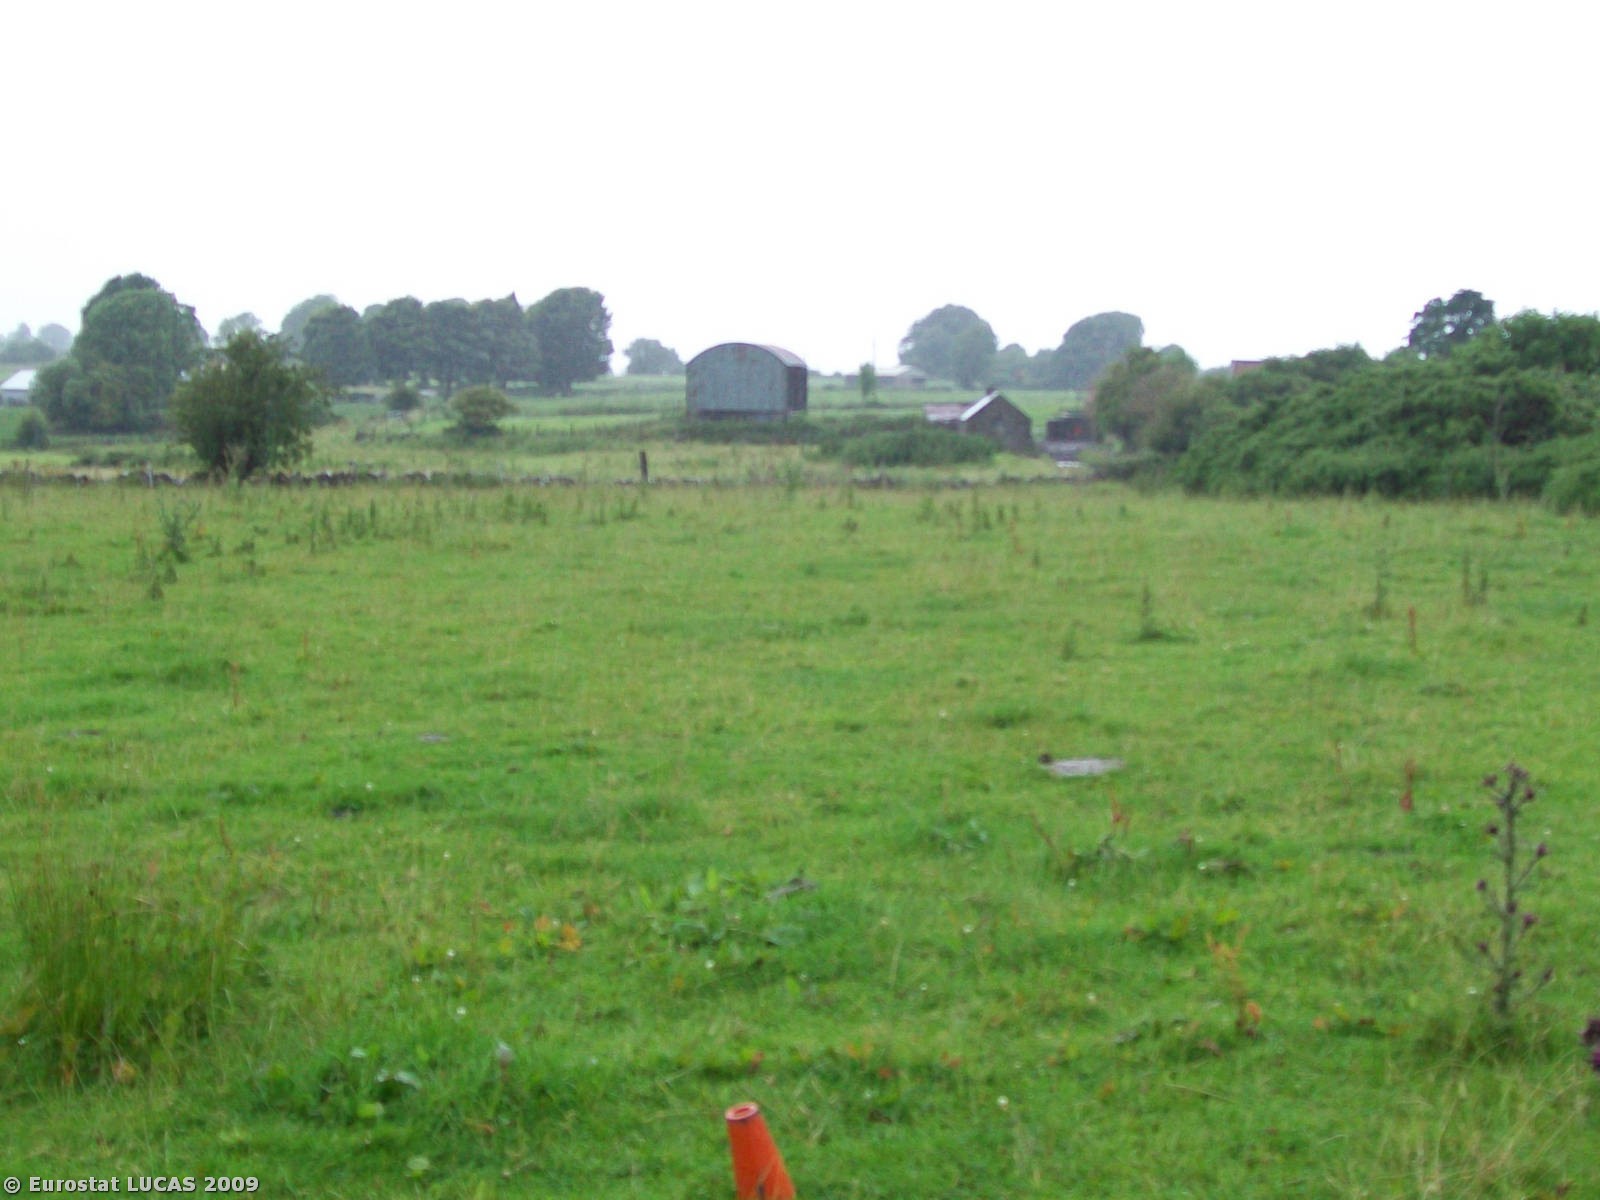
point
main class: Grassland
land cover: Grassland without tree/shrub cover
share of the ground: > 75 %
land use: Agriculture (excluding fallow land and kitchen gardens)
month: July
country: IE
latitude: 53.6255
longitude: -8.9439
